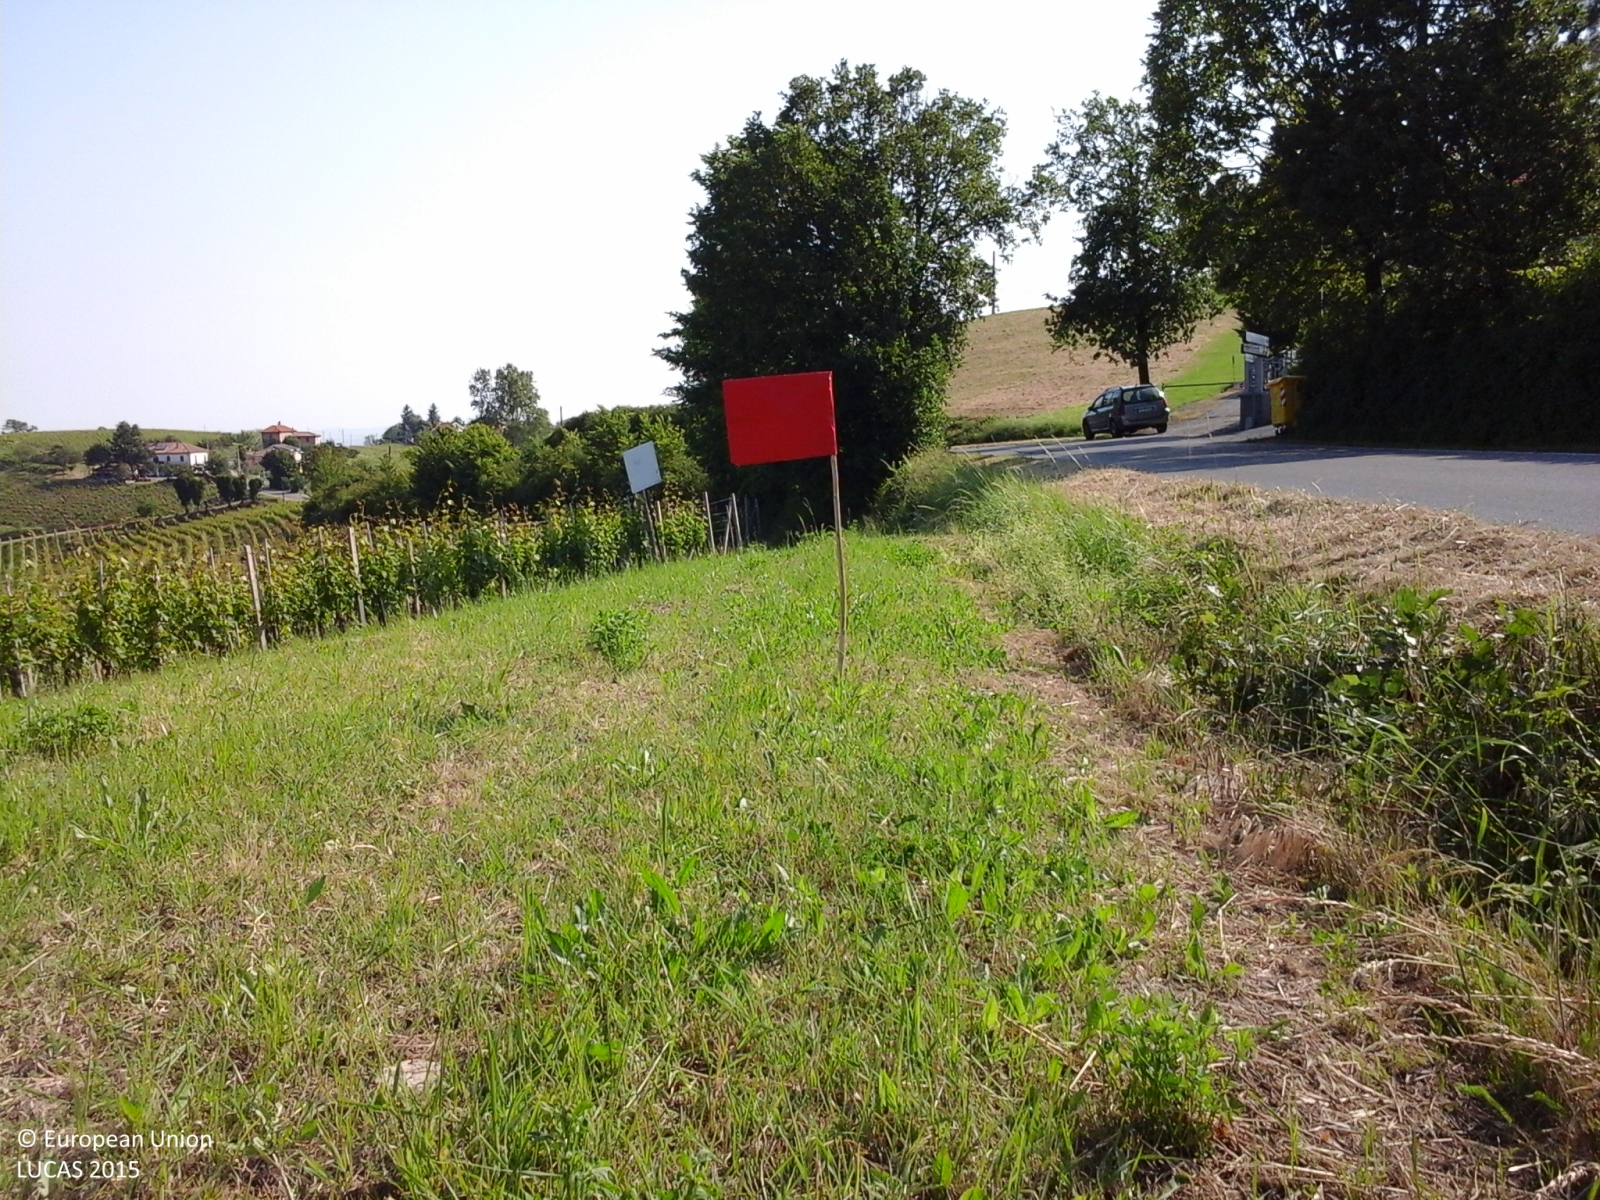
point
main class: Grassland
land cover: Grassland without tree/shrub cover
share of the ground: > 75 %
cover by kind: herbaceous plants 100 %
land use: Agriculture (excluding fallow land and kitchen gardens)
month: May
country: IT
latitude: 44.7350
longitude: 8.3995
